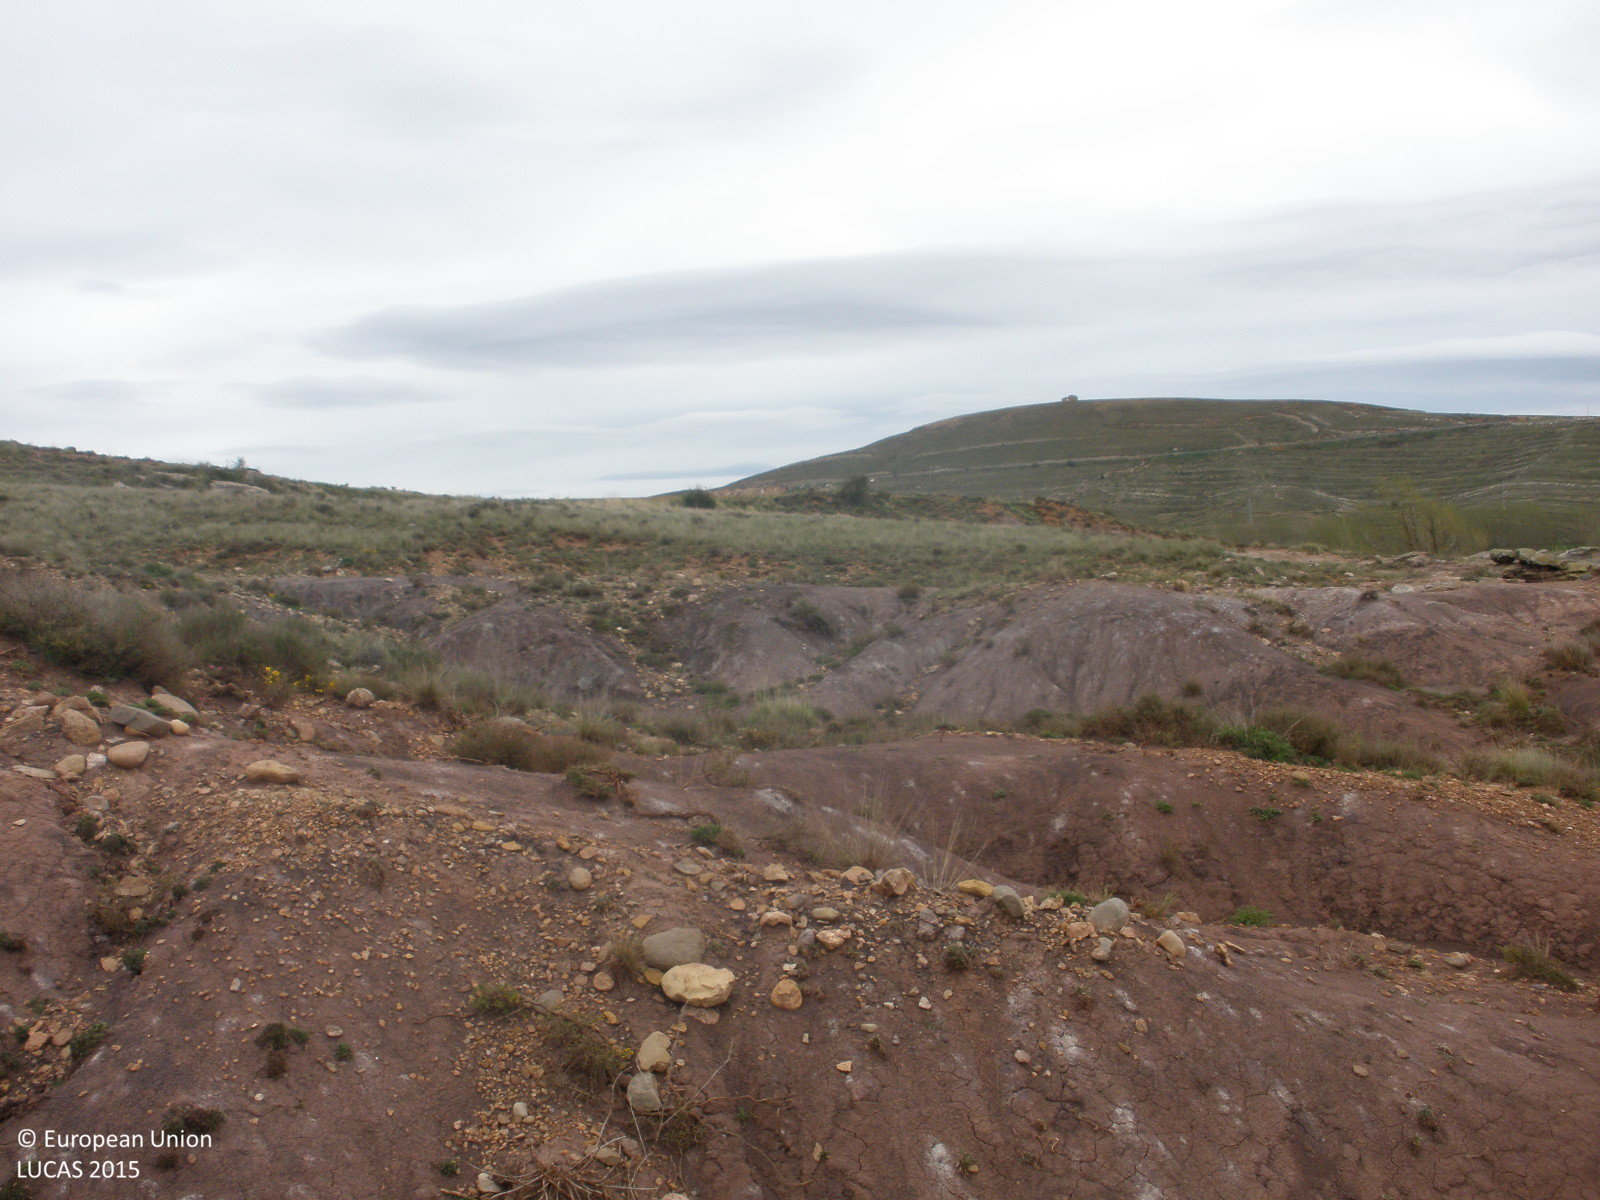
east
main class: Shrubland
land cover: Shrubland without tree cover
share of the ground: 25 - 50 %
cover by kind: consolidated bare surface 50 %, shrubs 30 %, herbaceous plants 20 %
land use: Semi-natural and natural areas not in use
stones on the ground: 10 - 25 %
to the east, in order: Shrubland without tree cover; Other bare soil; Shrubland without tree cover; Tracks; Shrubland without tree cover; Spontaneously vegetated surfaces; Grass margins; Other bare soil
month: May
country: ES
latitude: 40.5609
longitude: -0.8175
